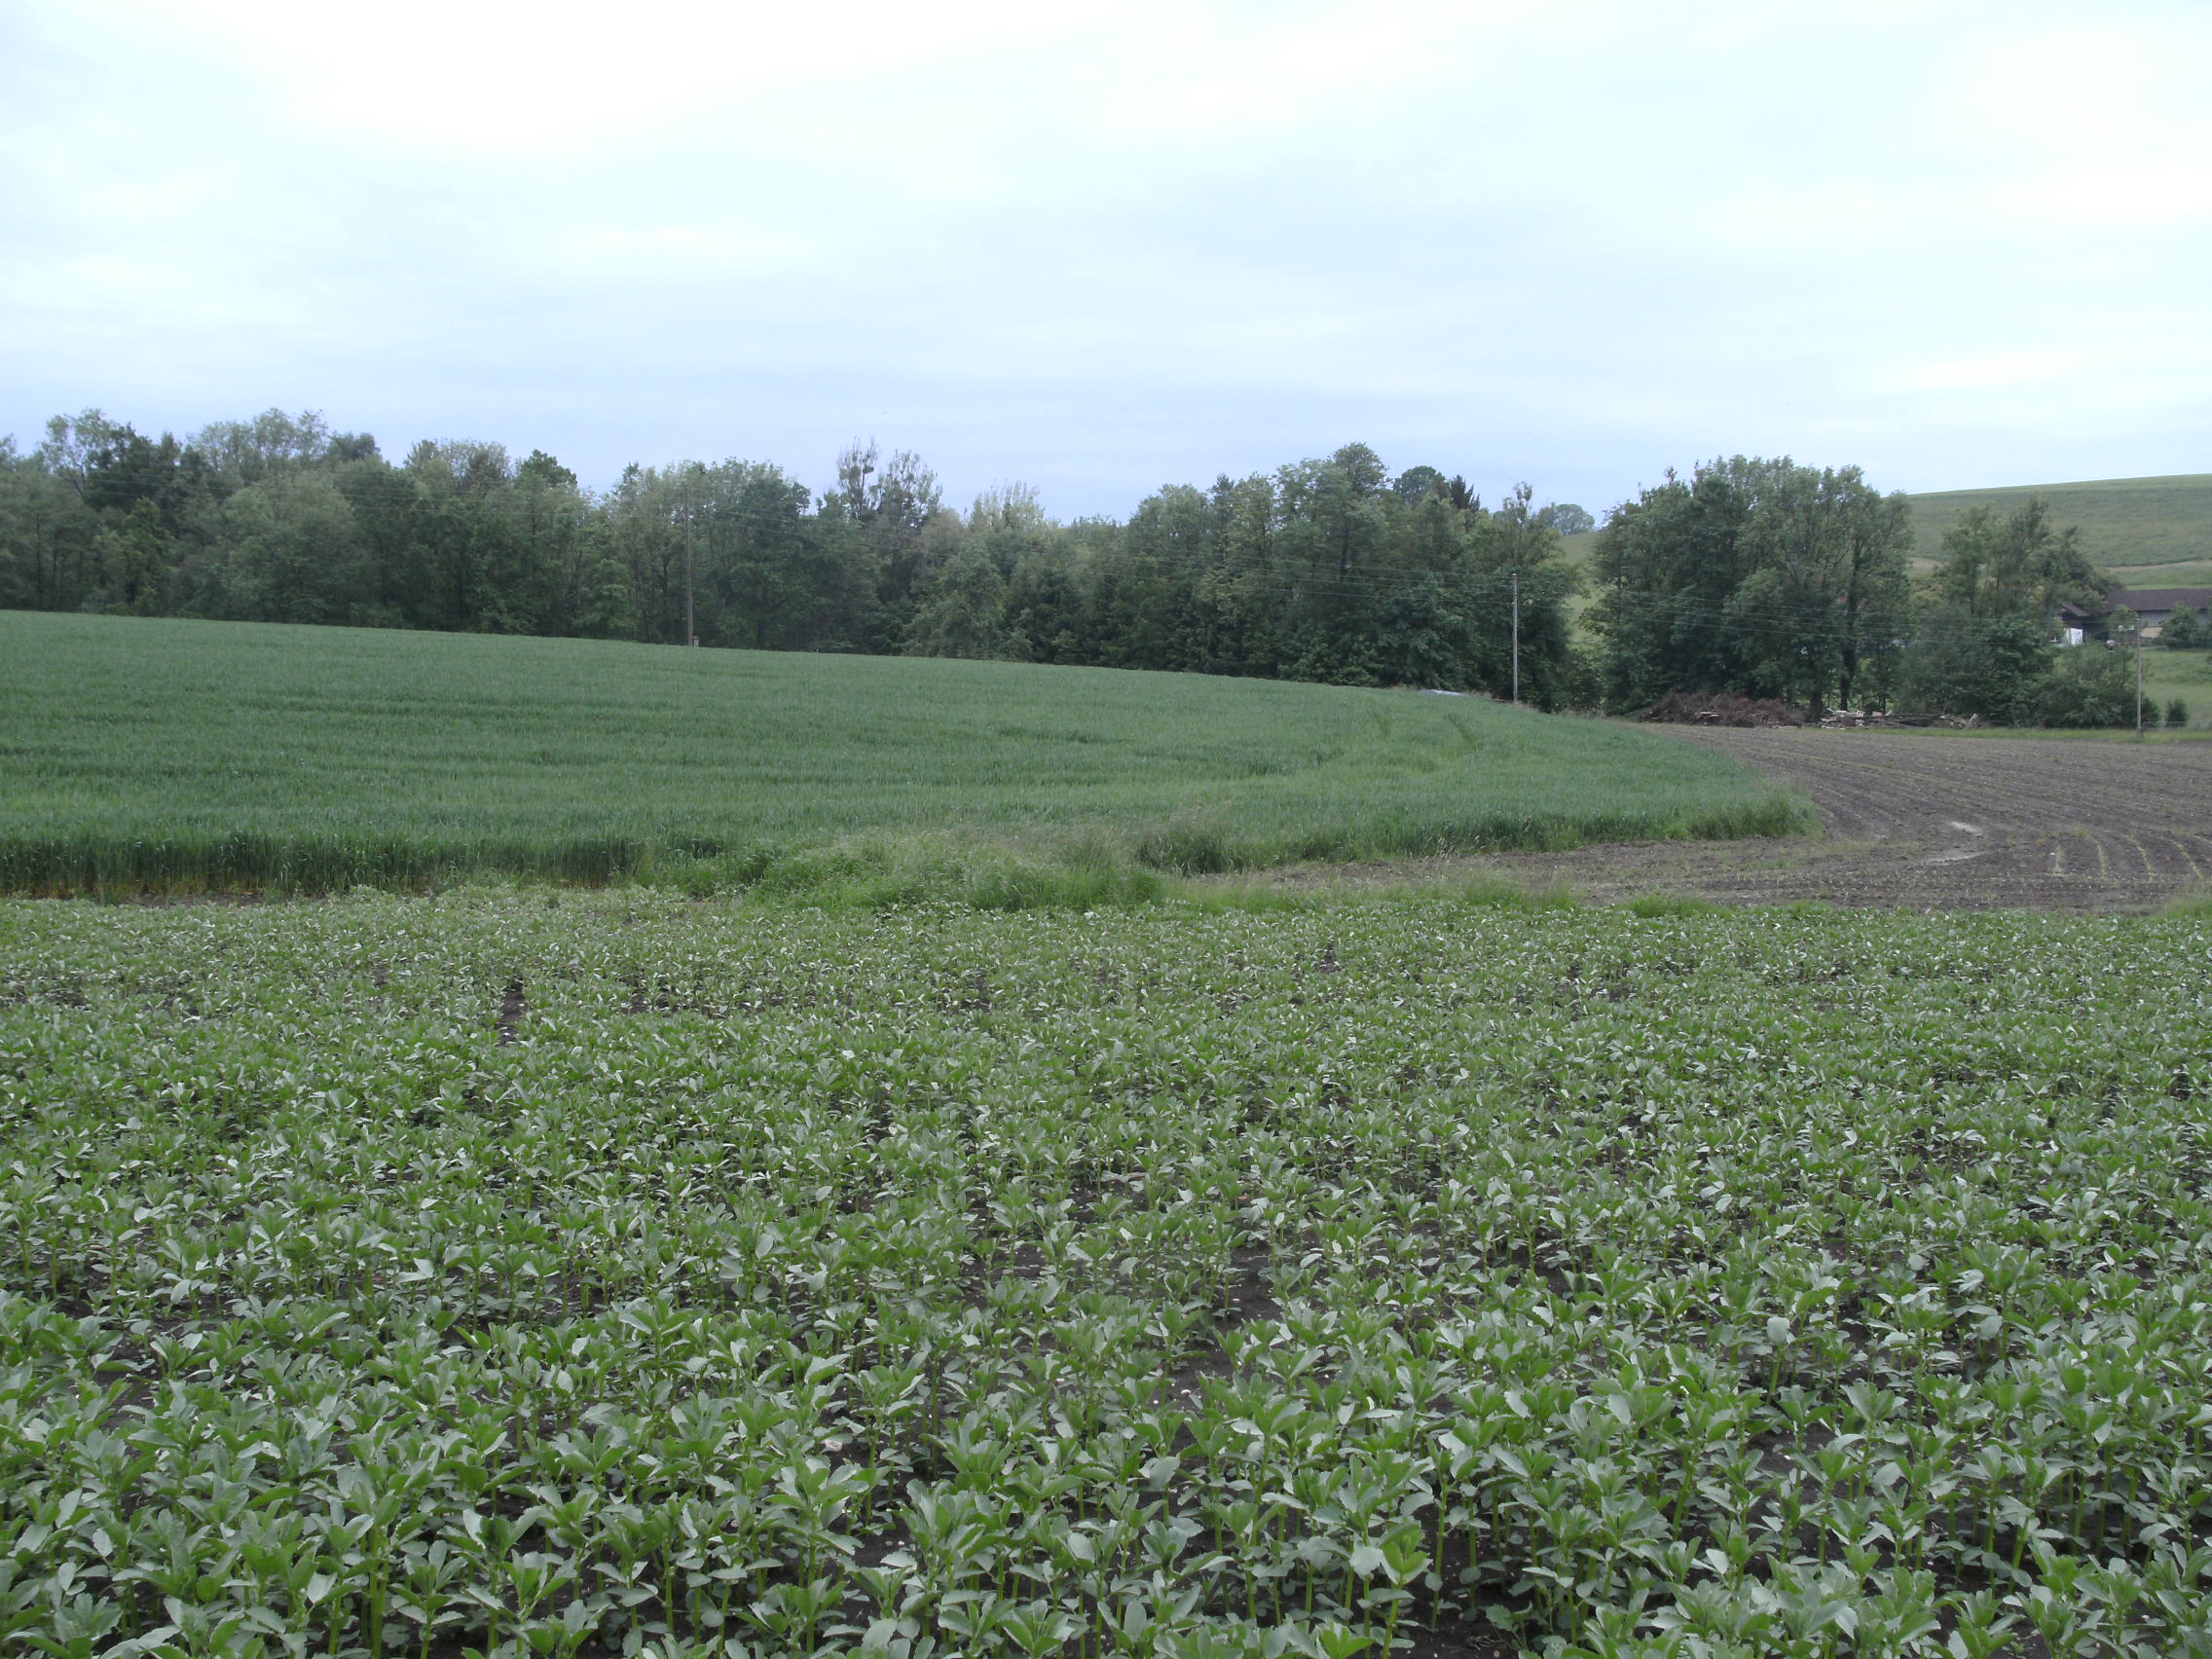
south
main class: Cropland
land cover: Dry pulses
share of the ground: 50 - 75 %
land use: Agriculture (excluding fallow land and kitchen gardens)
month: May
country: AT
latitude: 48.2747
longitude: 13.5431
